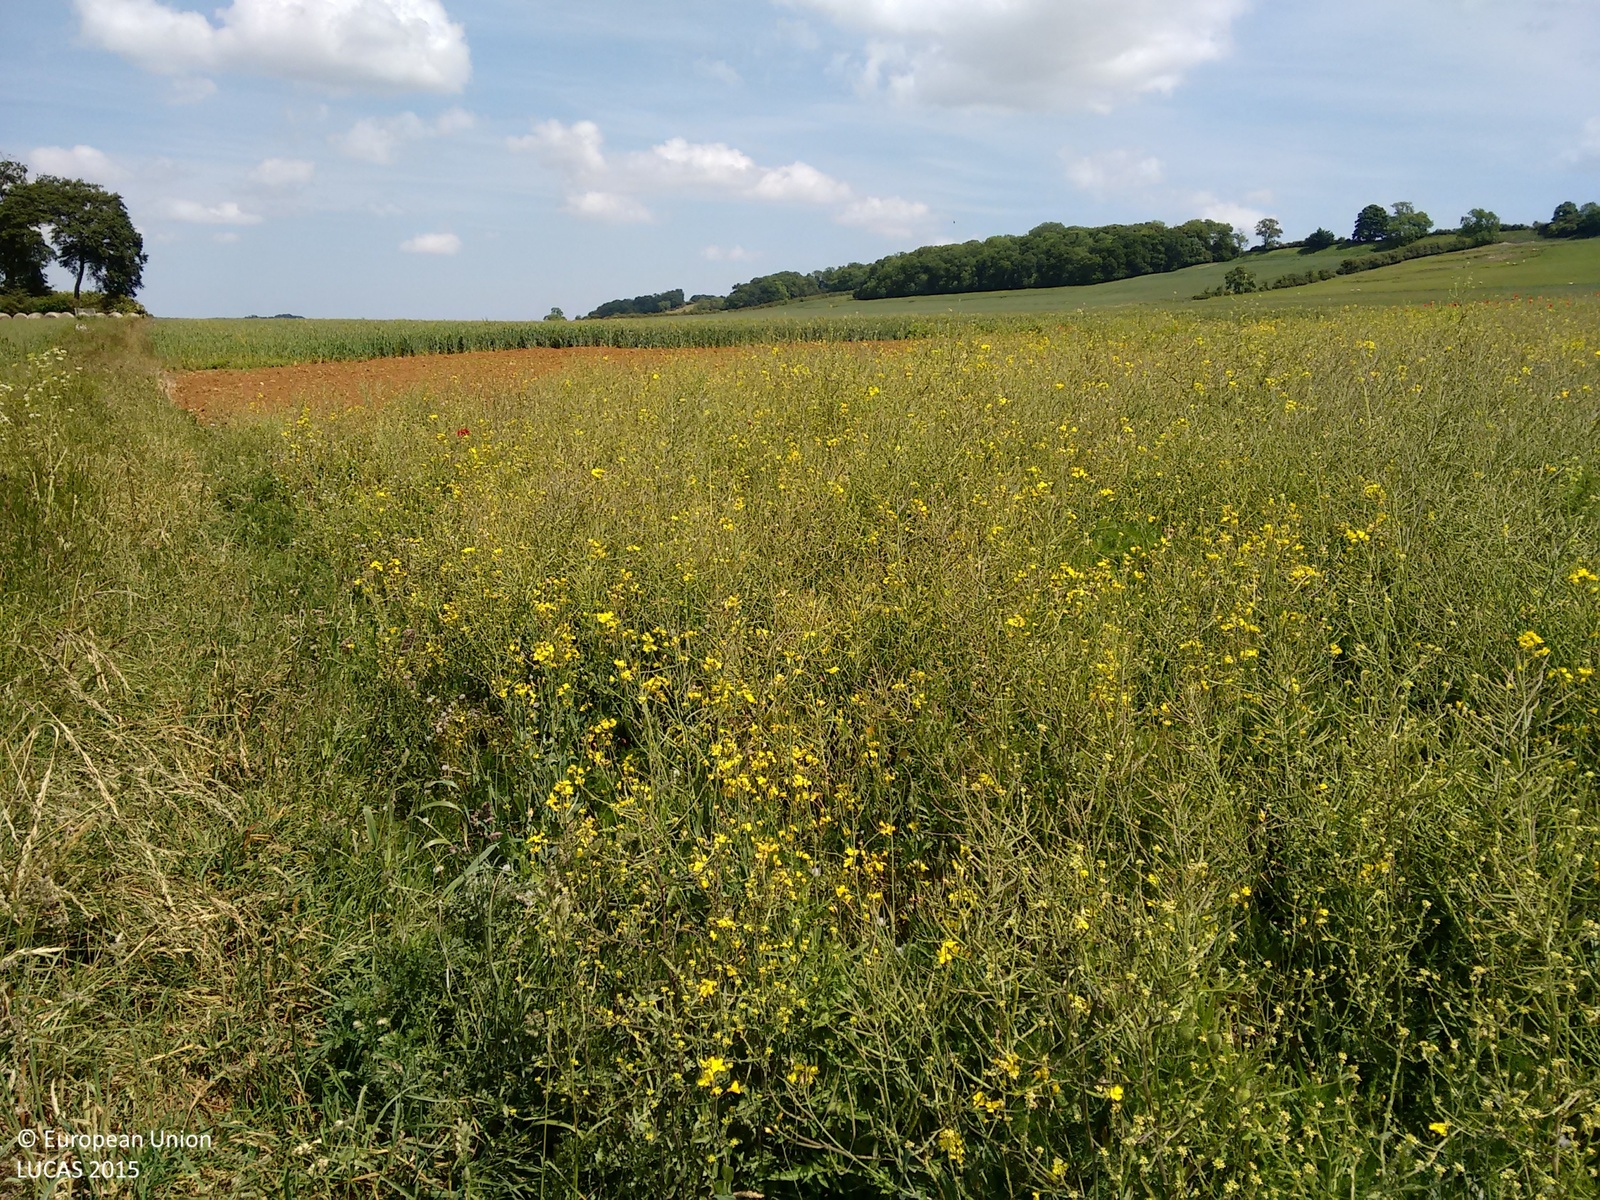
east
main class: Cropland
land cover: Rape and turnip rape
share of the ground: > 75 %
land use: Agriculture (excluding fallow land and kitchen gardens)
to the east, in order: Rape and turnip rape; Maize; Common wheat
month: June
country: GB
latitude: 52.9719
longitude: -0.5966
